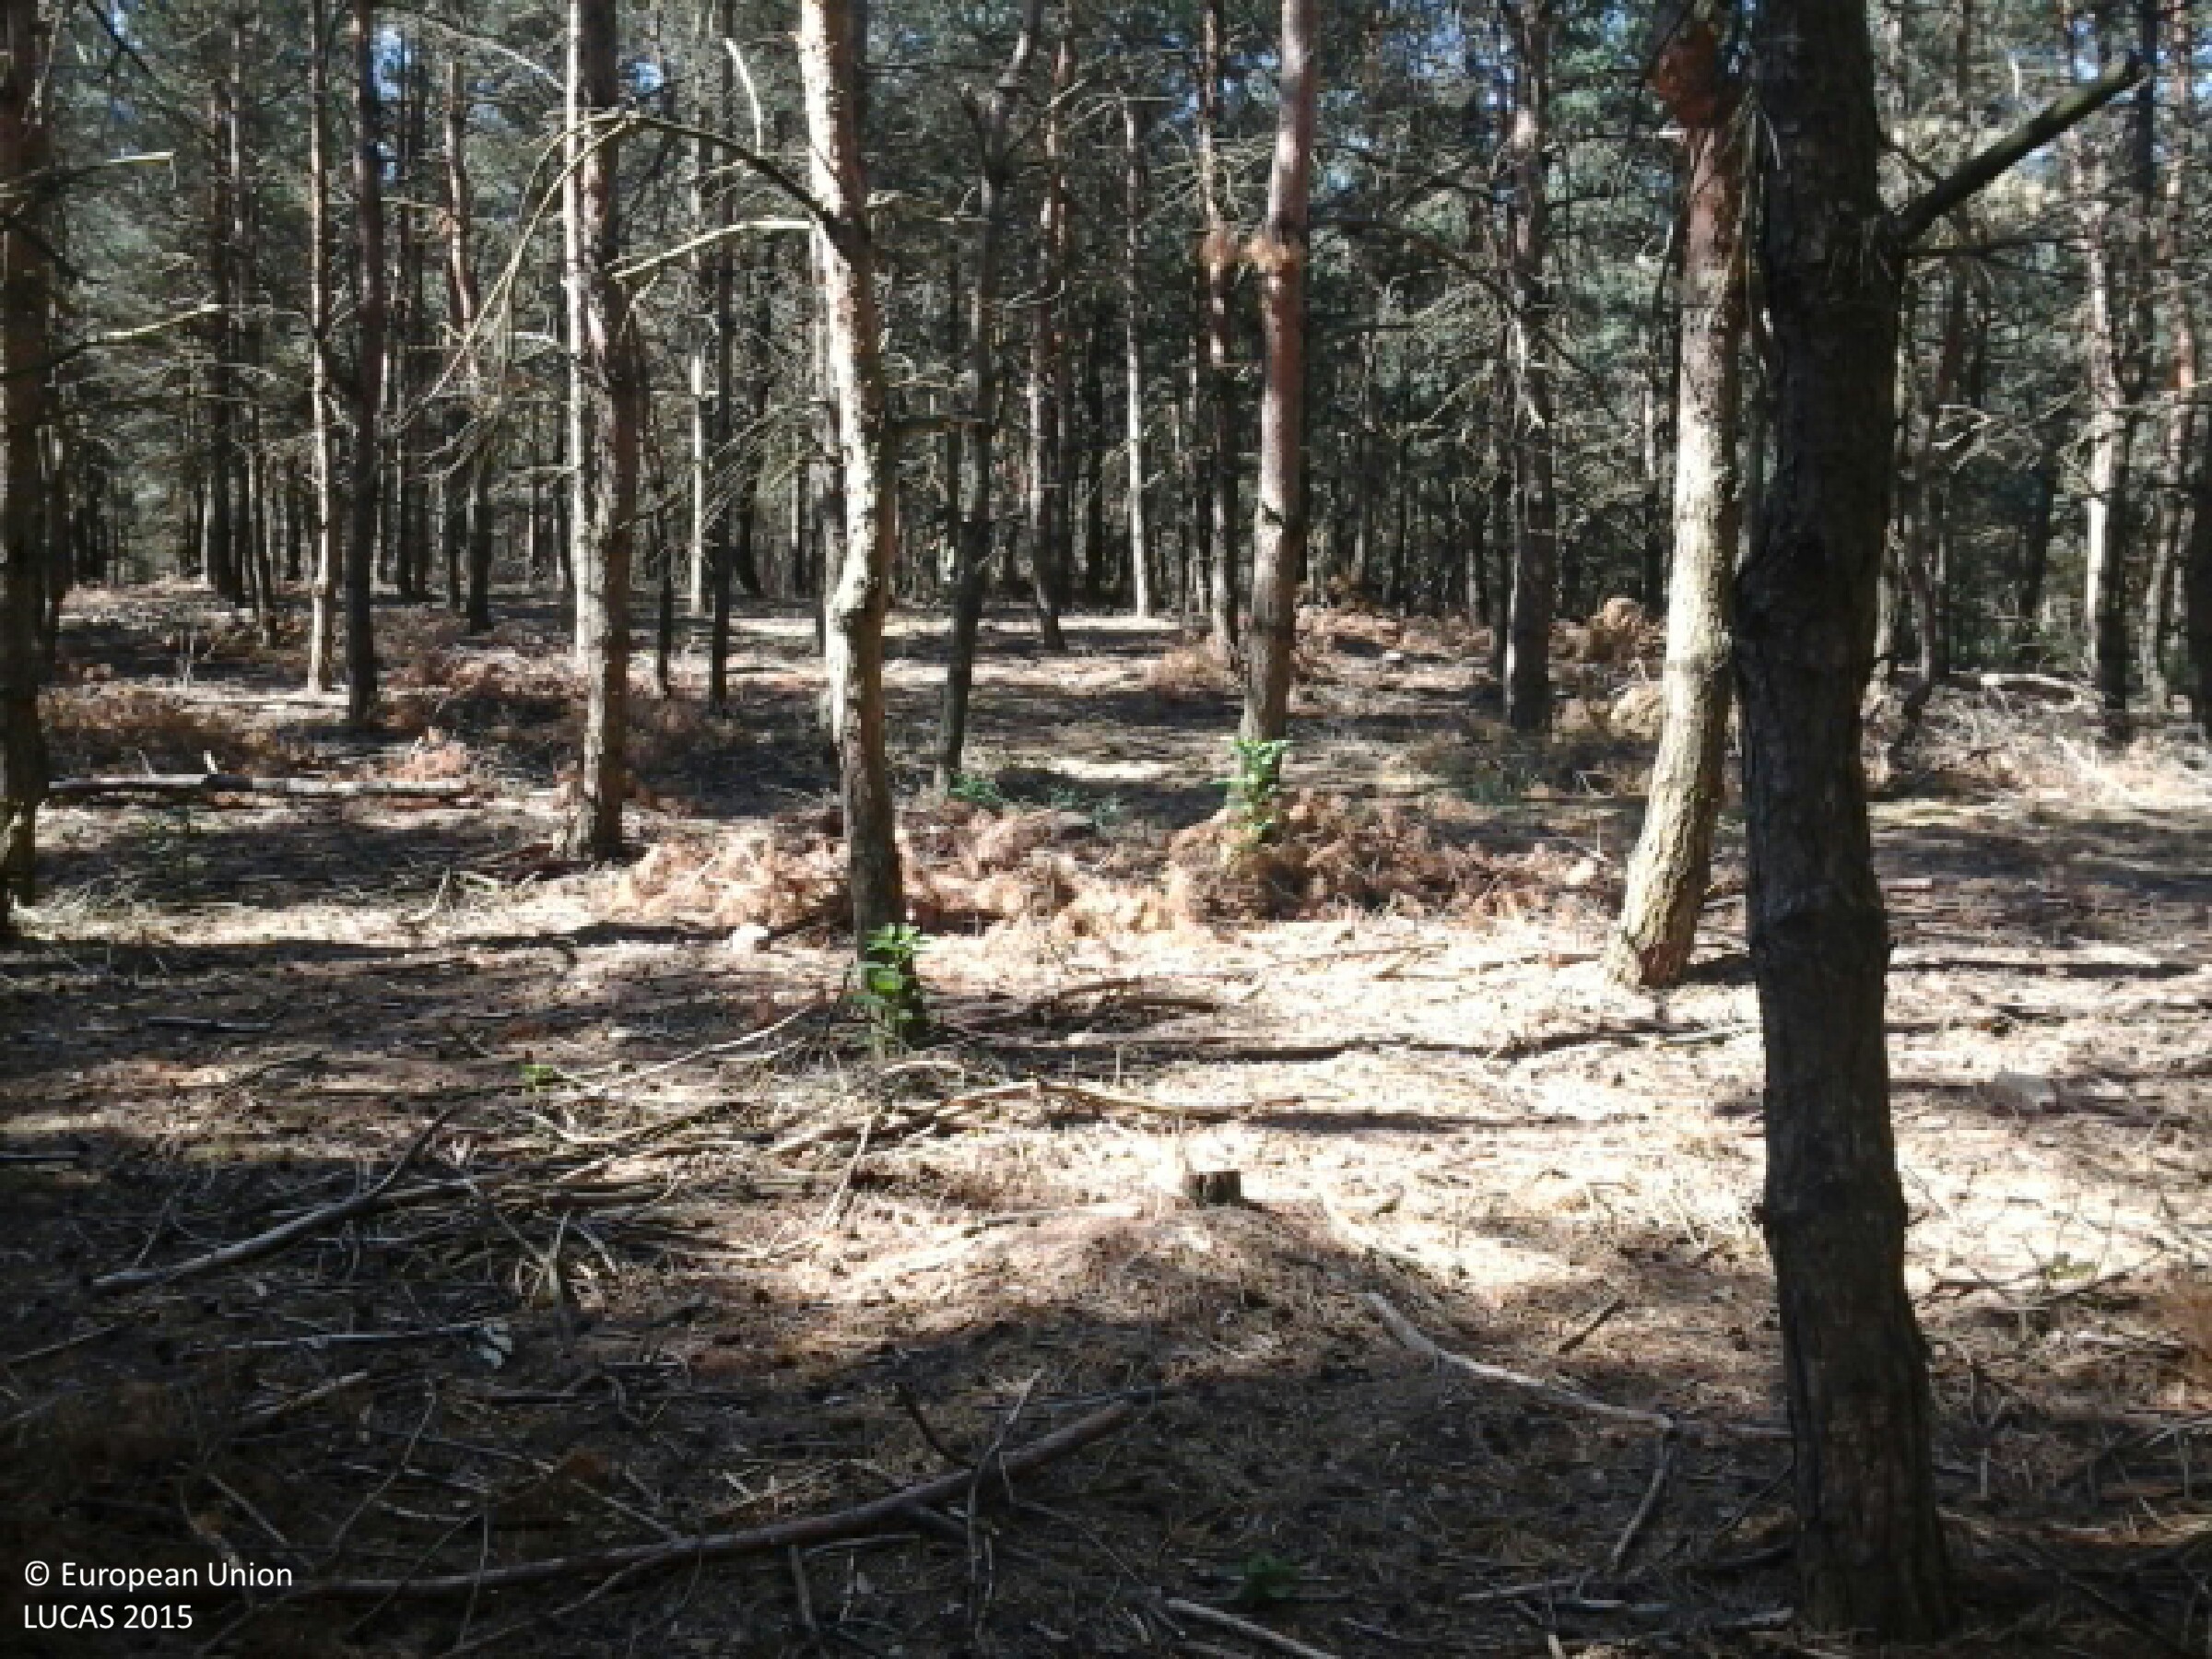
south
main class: Woodland
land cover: Pine dominated coniferous woodland
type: hemiboreal forest and nemoral coniferous forest and mixed broadleaved-coniferous forest
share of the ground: > 75 %
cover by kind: coniferous forest trees 85 %, consolidated bare surface 10 %, shrubs 5 %
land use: Forestry
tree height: > 5 m
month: July
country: HU
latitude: 47.9613
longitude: 22.2019
